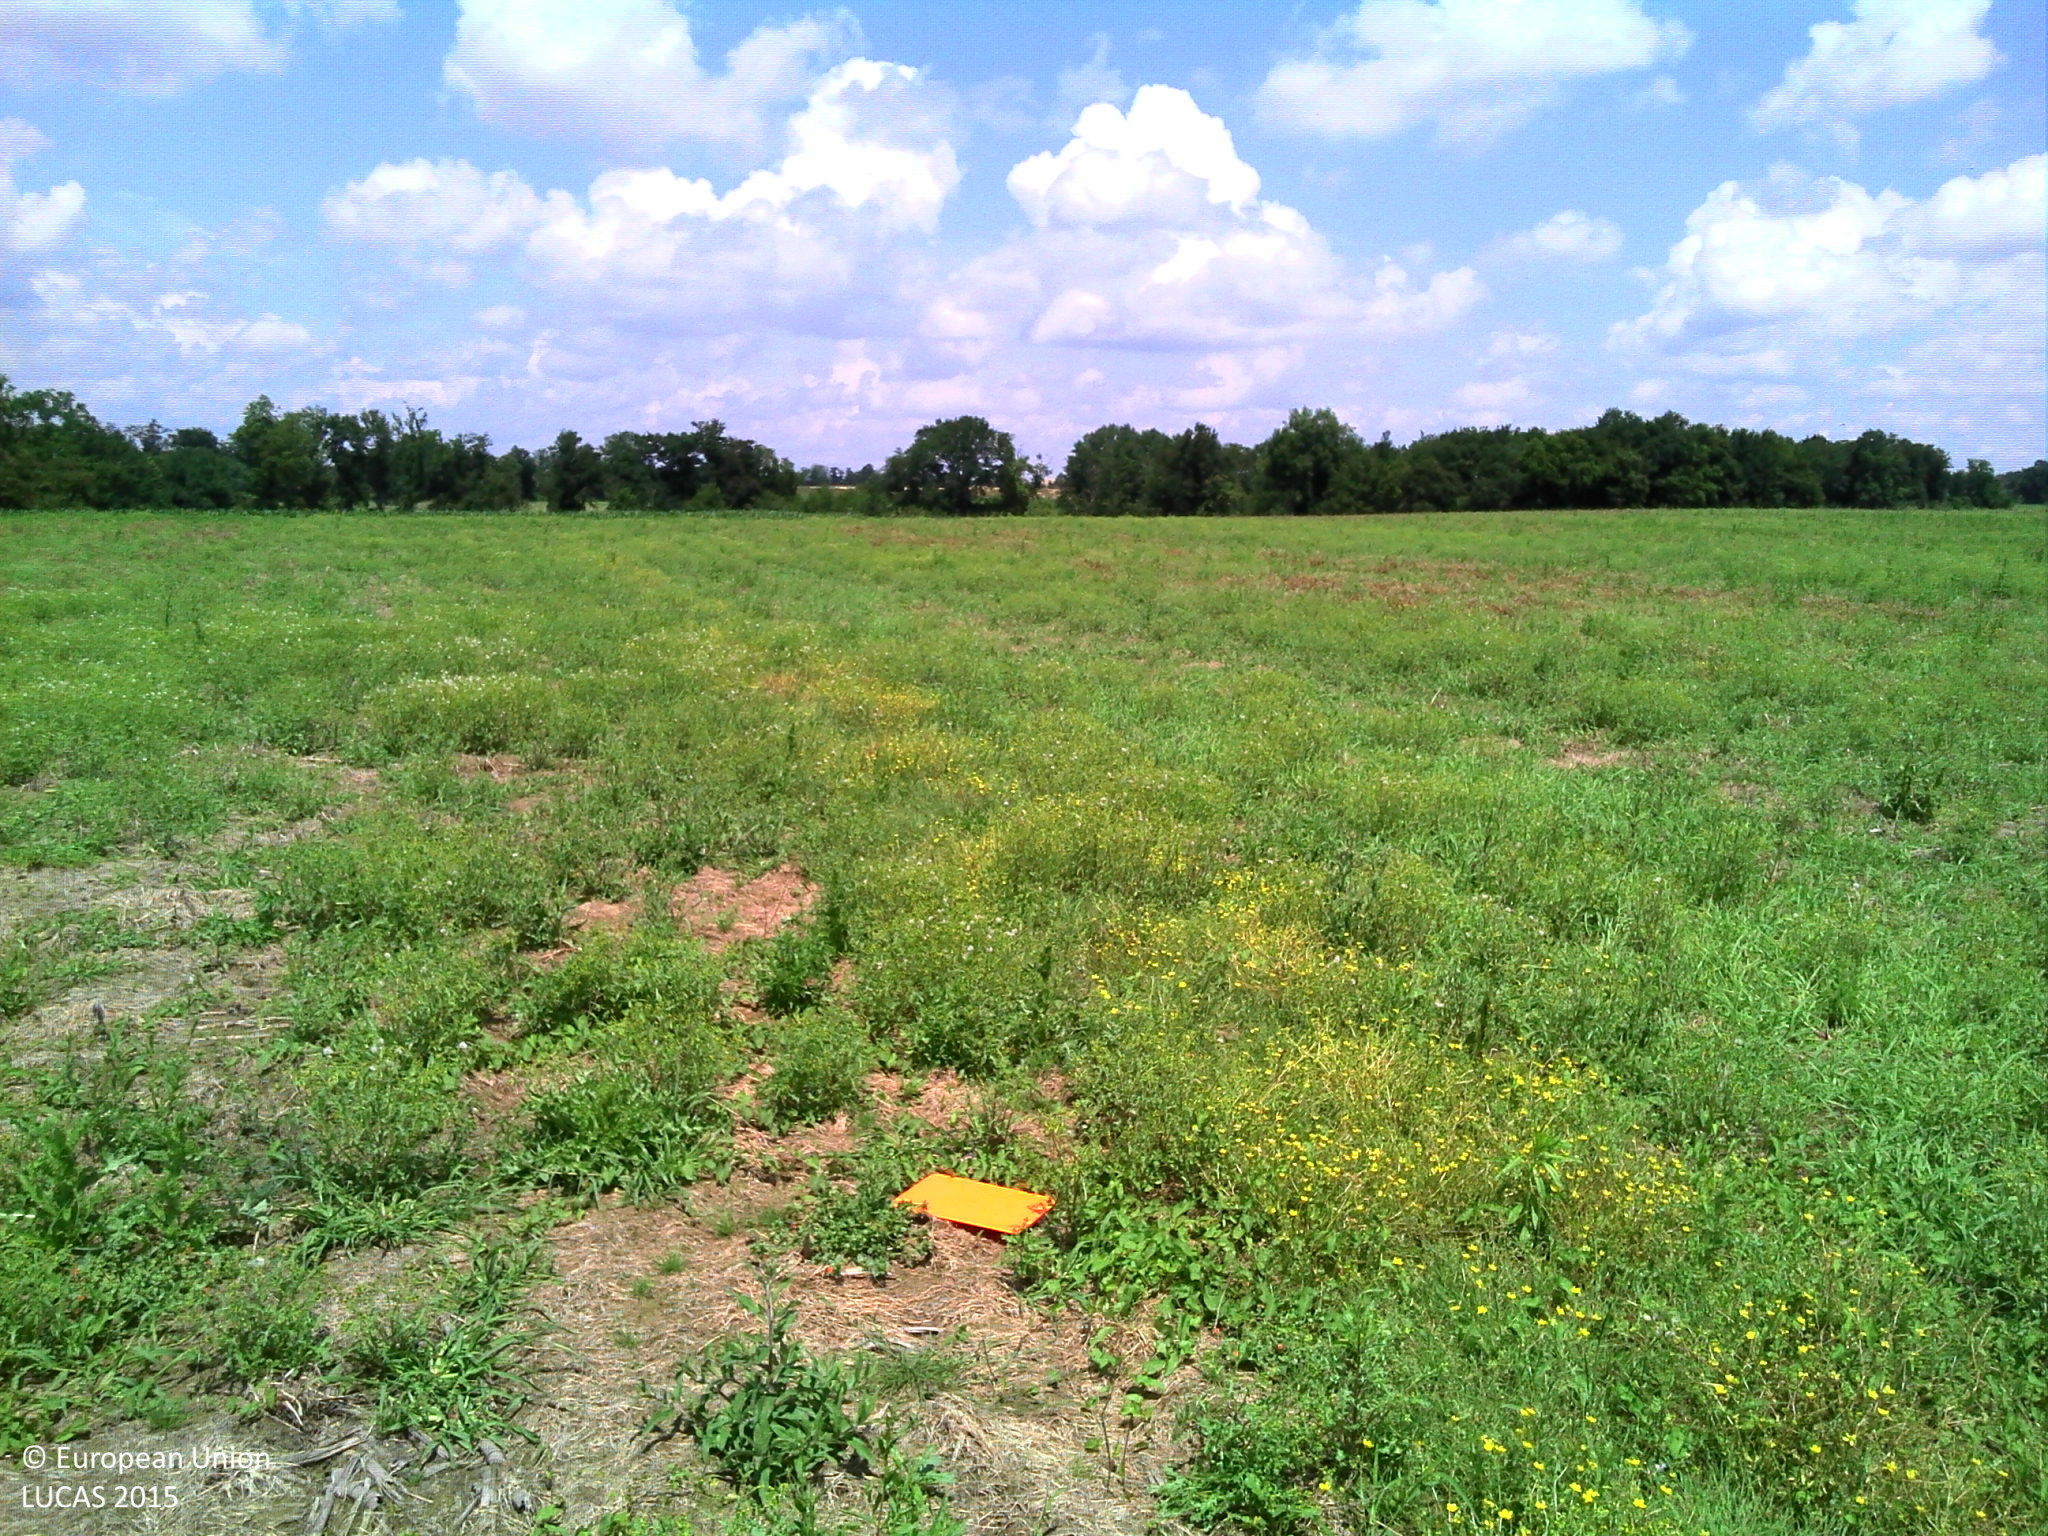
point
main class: Grassland
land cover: Spontaneously vegetated surfaces
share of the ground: > 75 %
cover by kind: herbaceous plants 75 %, unconsolidated bare surface 25 %
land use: Agriculture (excluding fallow land and kitchen gardens)
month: June
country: FR
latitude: 43.7350
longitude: -0.2268
